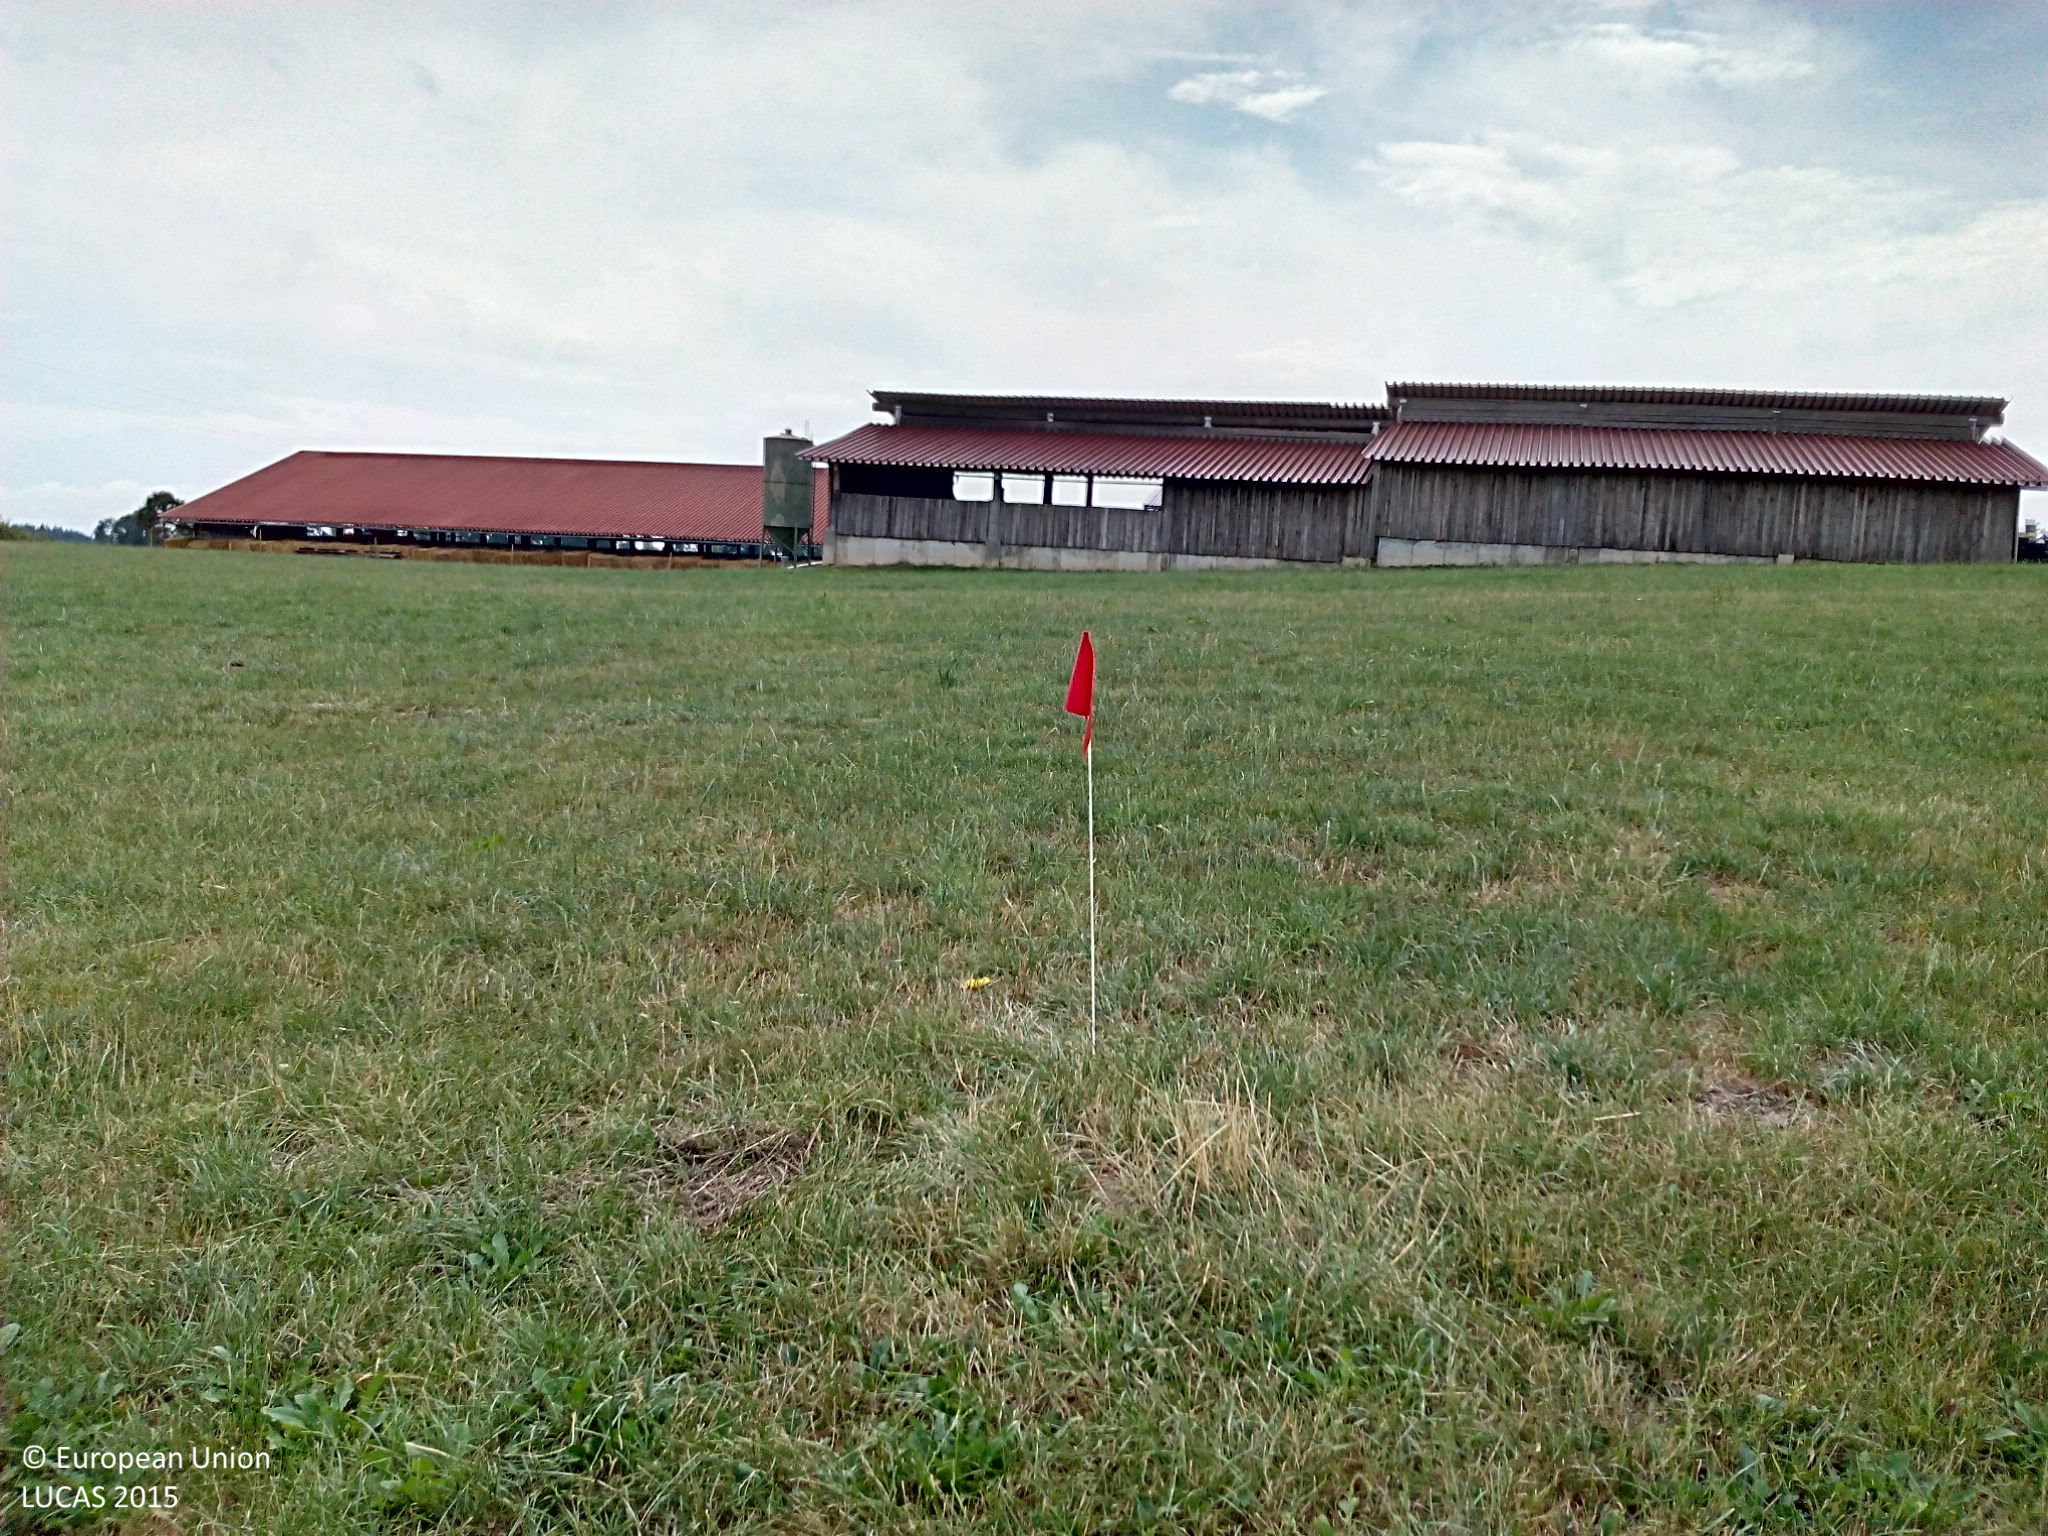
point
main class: Grassland
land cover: Grassland without tree/shrub cover
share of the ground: > 75 %
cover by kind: herbaceous plants 100 %
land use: Agriculture (excluding fallow land and kitchen gardens)
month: August
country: DE
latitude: 47.7040
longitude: 8.1489
